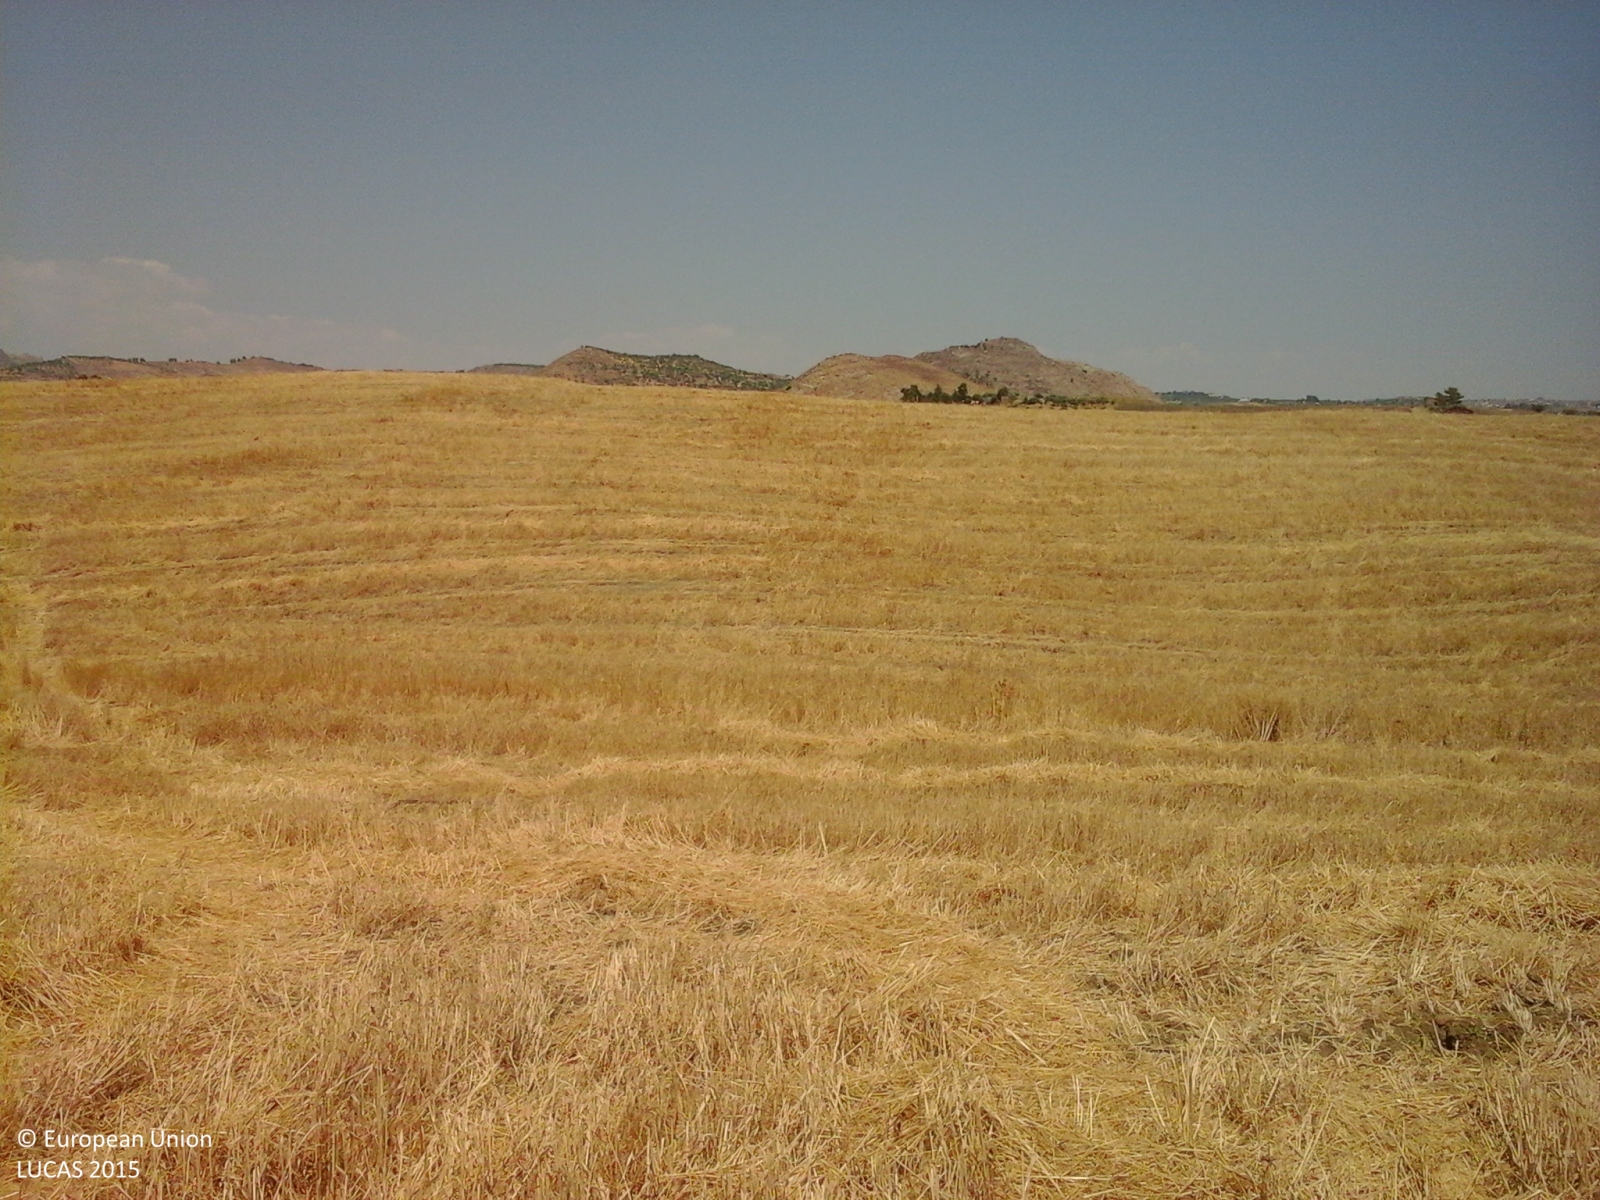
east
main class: Cropland
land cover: Durum wheat
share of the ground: > 75 %
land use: Agriculture (excluding fallow land and kitchen gardens)
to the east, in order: Durum wheat; Ditches and canals; Durum wheat; Ditches and canals
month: July
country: IT
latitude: 37.3937
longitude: 13.4635
